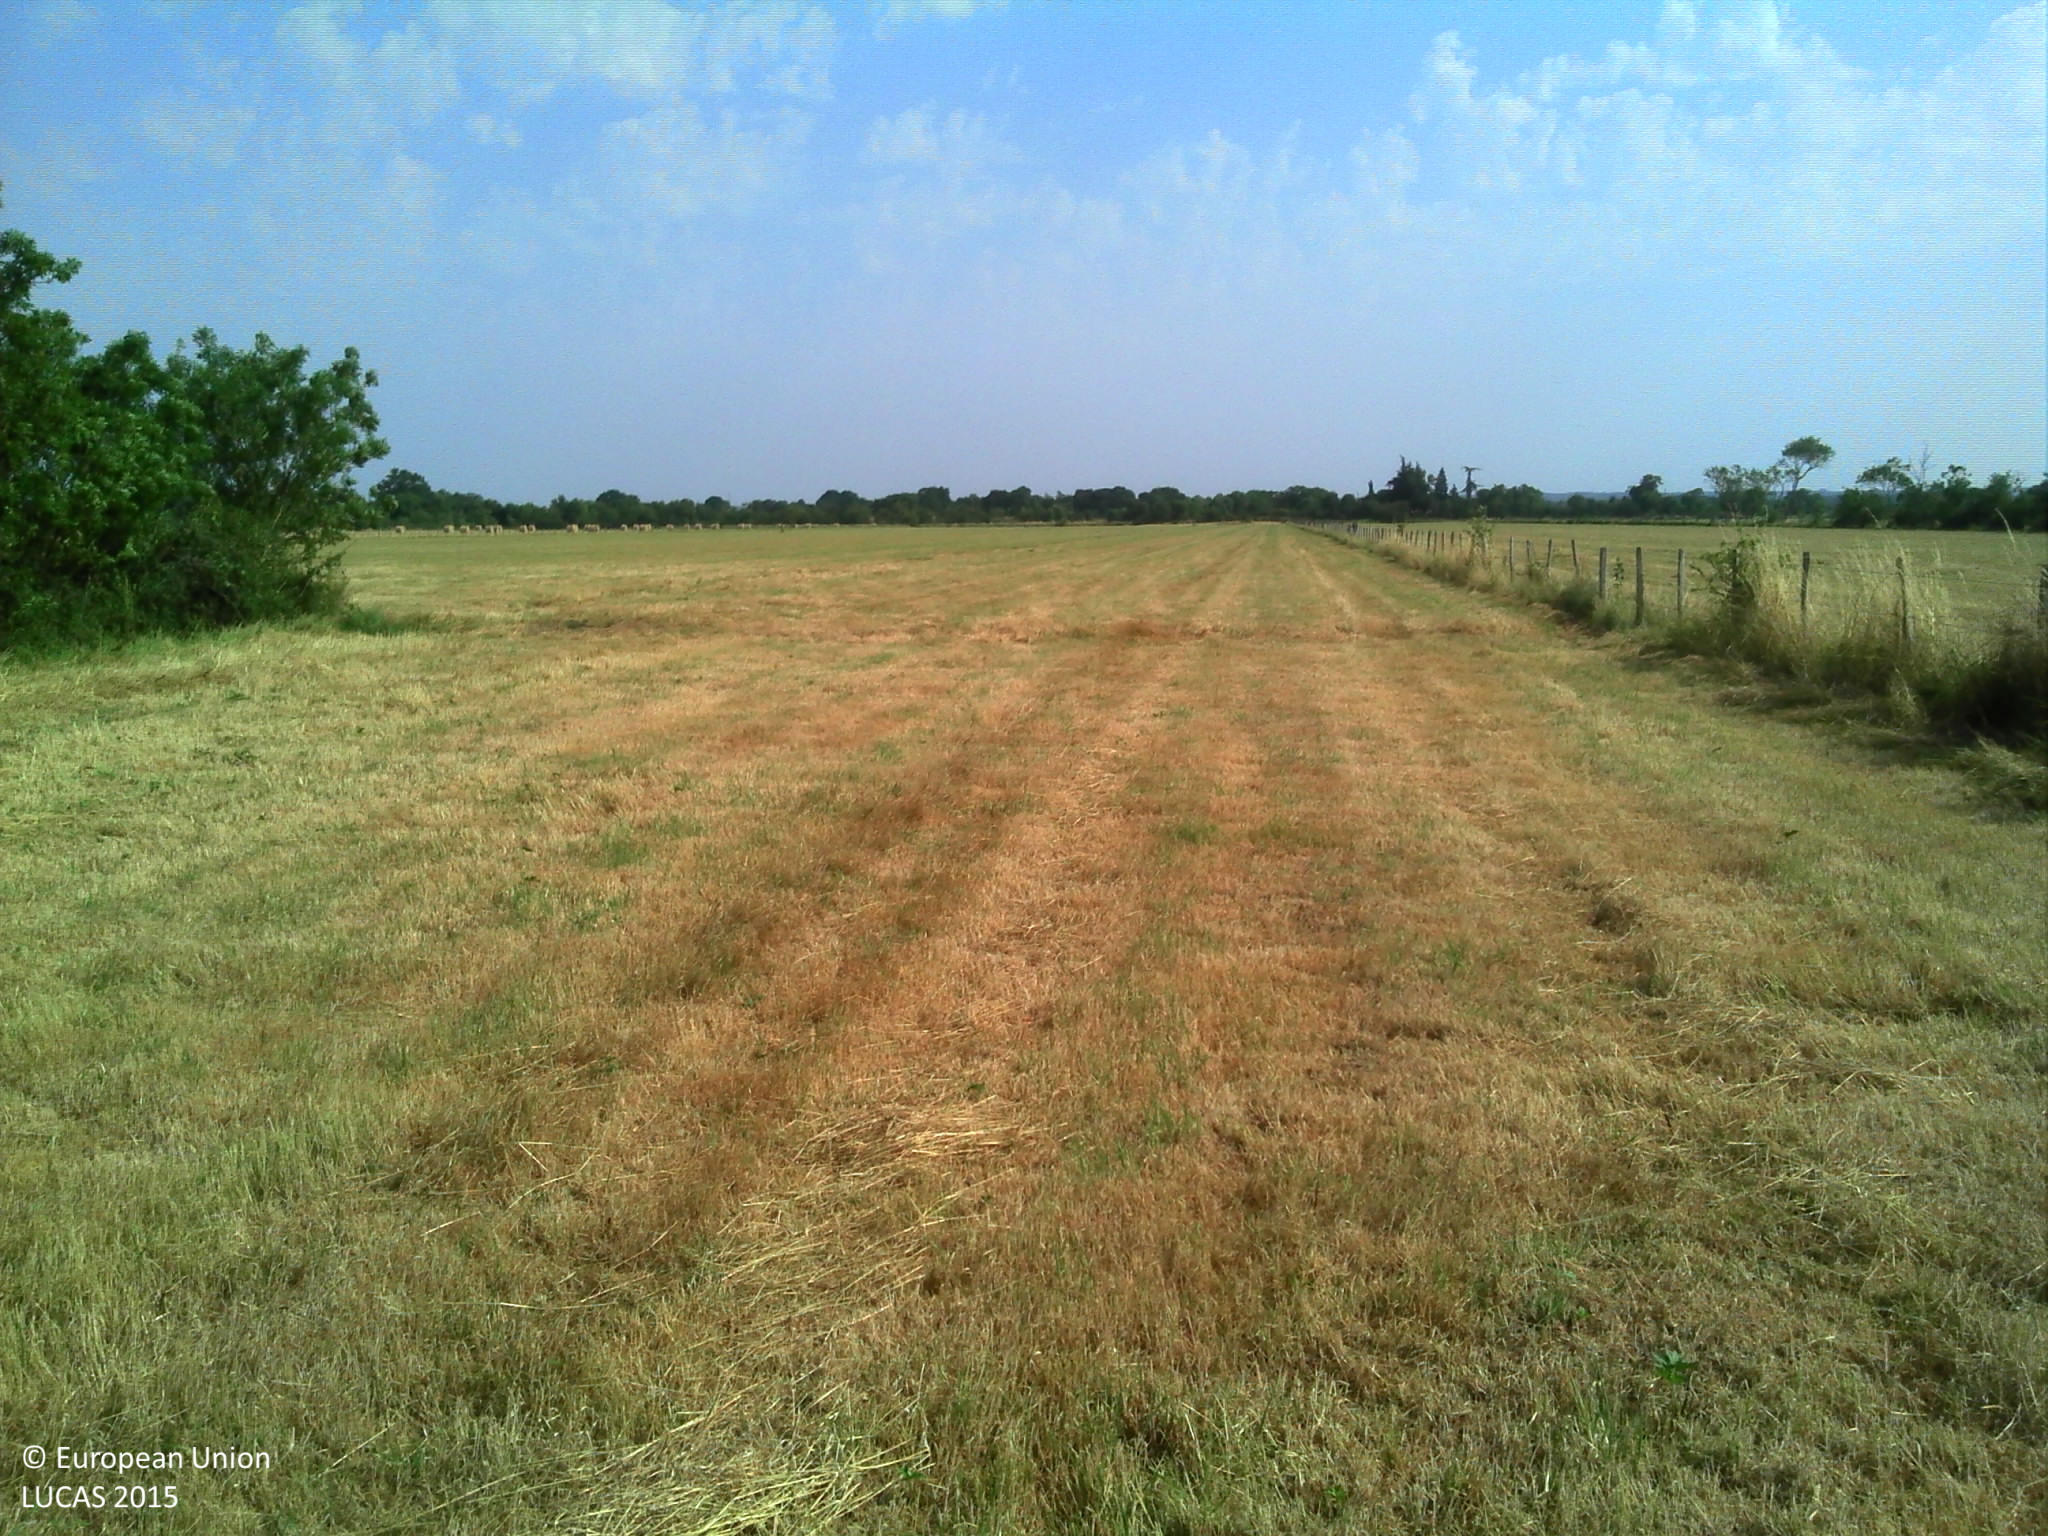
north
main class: Grassland
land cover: Grassland without tree/shrub cover
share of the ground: > 75 %
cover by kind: herbaceous plants 100 %
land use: Agriculture (excluding fallow land and kitchen gardens)
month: July
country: FR
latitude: 47.3114
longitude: -1.9934
